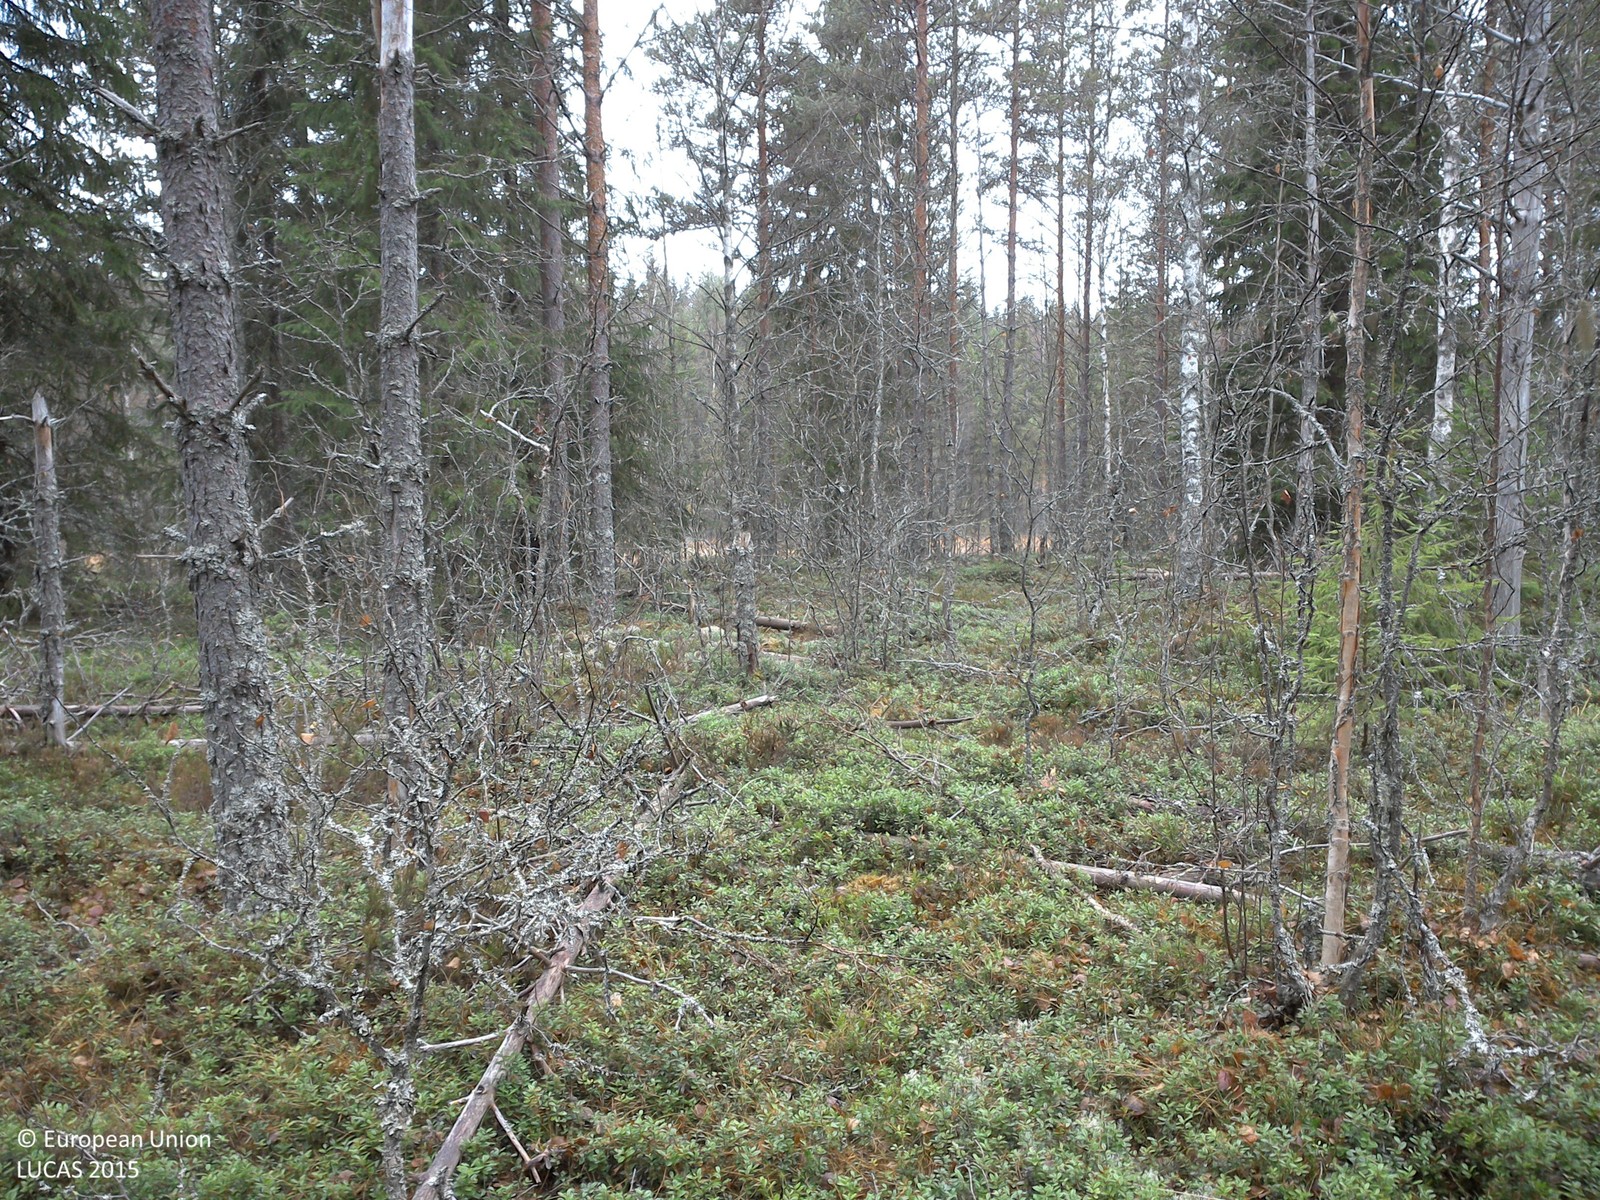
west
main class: Woodland
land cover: Pine dominated coniferous woodland
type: boreal forest
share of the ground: > 75 %
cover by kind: coniferous forest trees 65 %, shrubs 20 %, broadleaved forest trees 15 %
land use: Forestry
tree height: > 5 m
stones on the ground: < 10 %
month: November
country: SE
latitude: 60.1726
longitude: 14.1890
